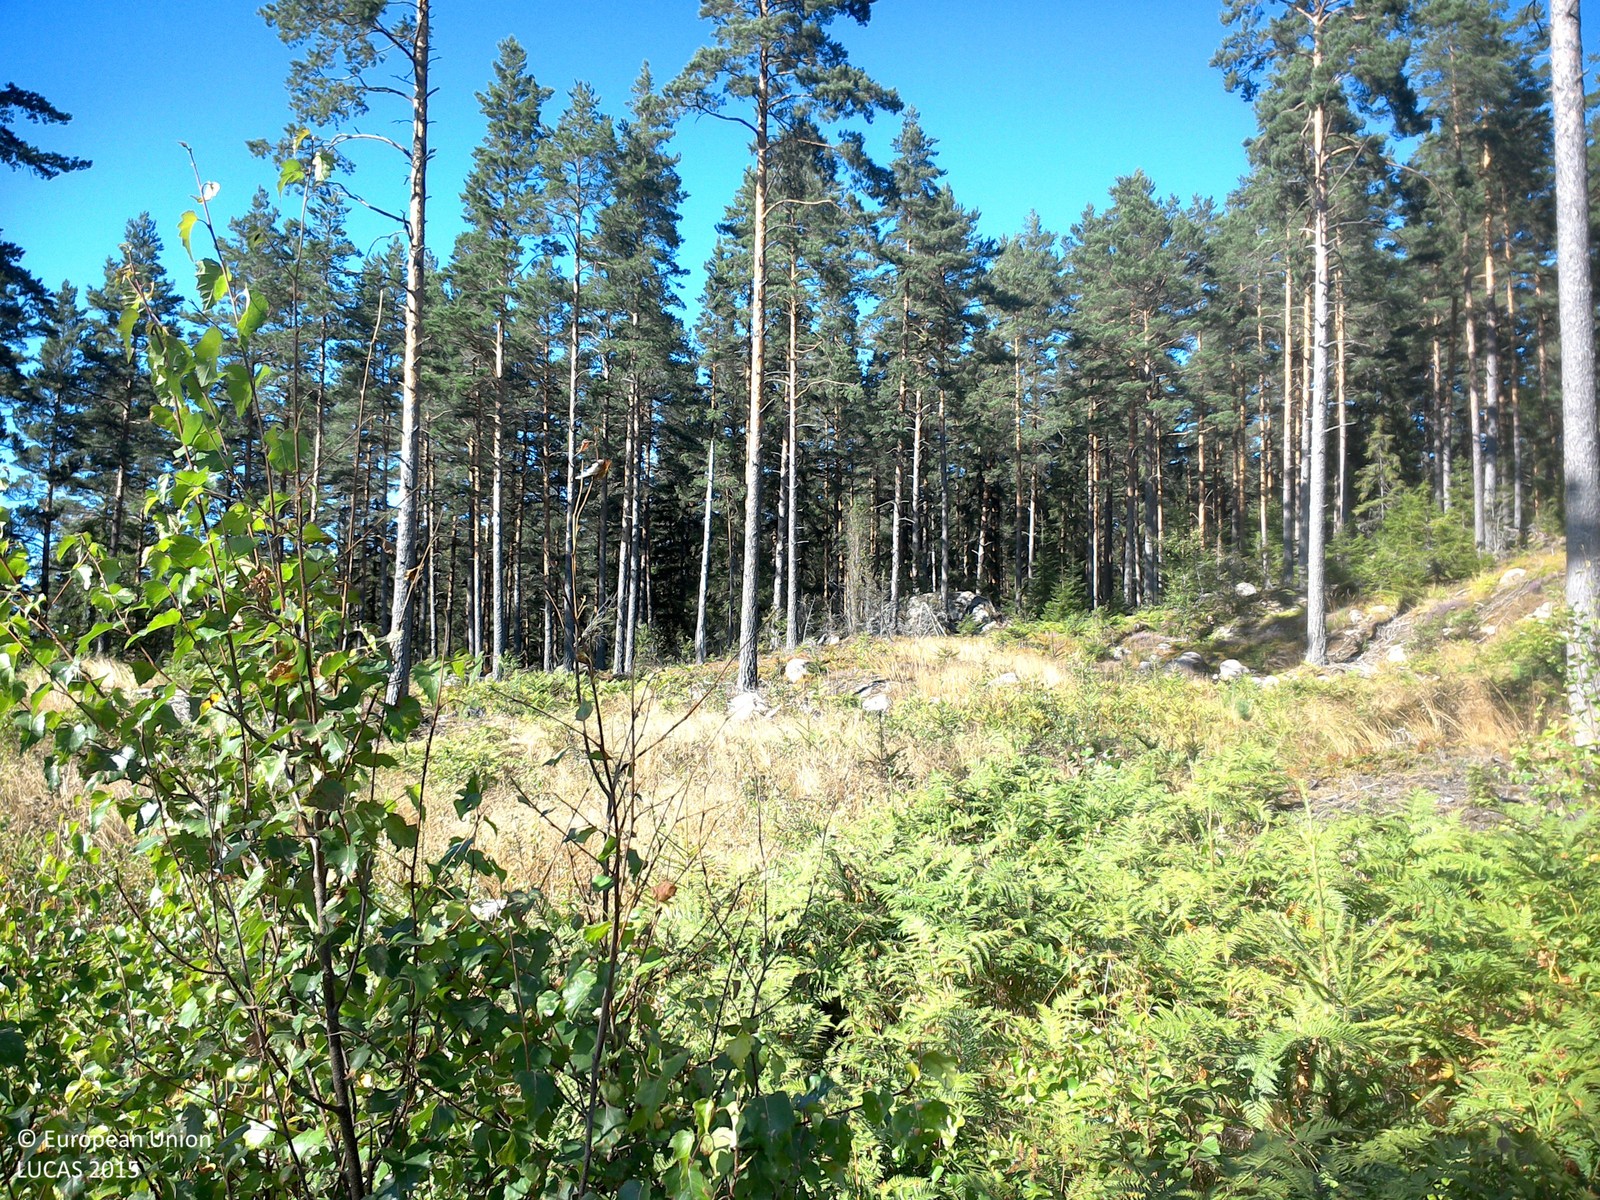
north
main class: Grassland
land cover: Grassland with sparse tree/shrub cover
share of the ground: > 75 %
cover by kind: herbaceous plants 90 %, broadleaved forest trees 5 %, unconsolidated bare surface 5 %
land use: Forestry
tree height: < 5 m
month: August
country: SE
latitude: 58.0623
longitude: 15.2661
